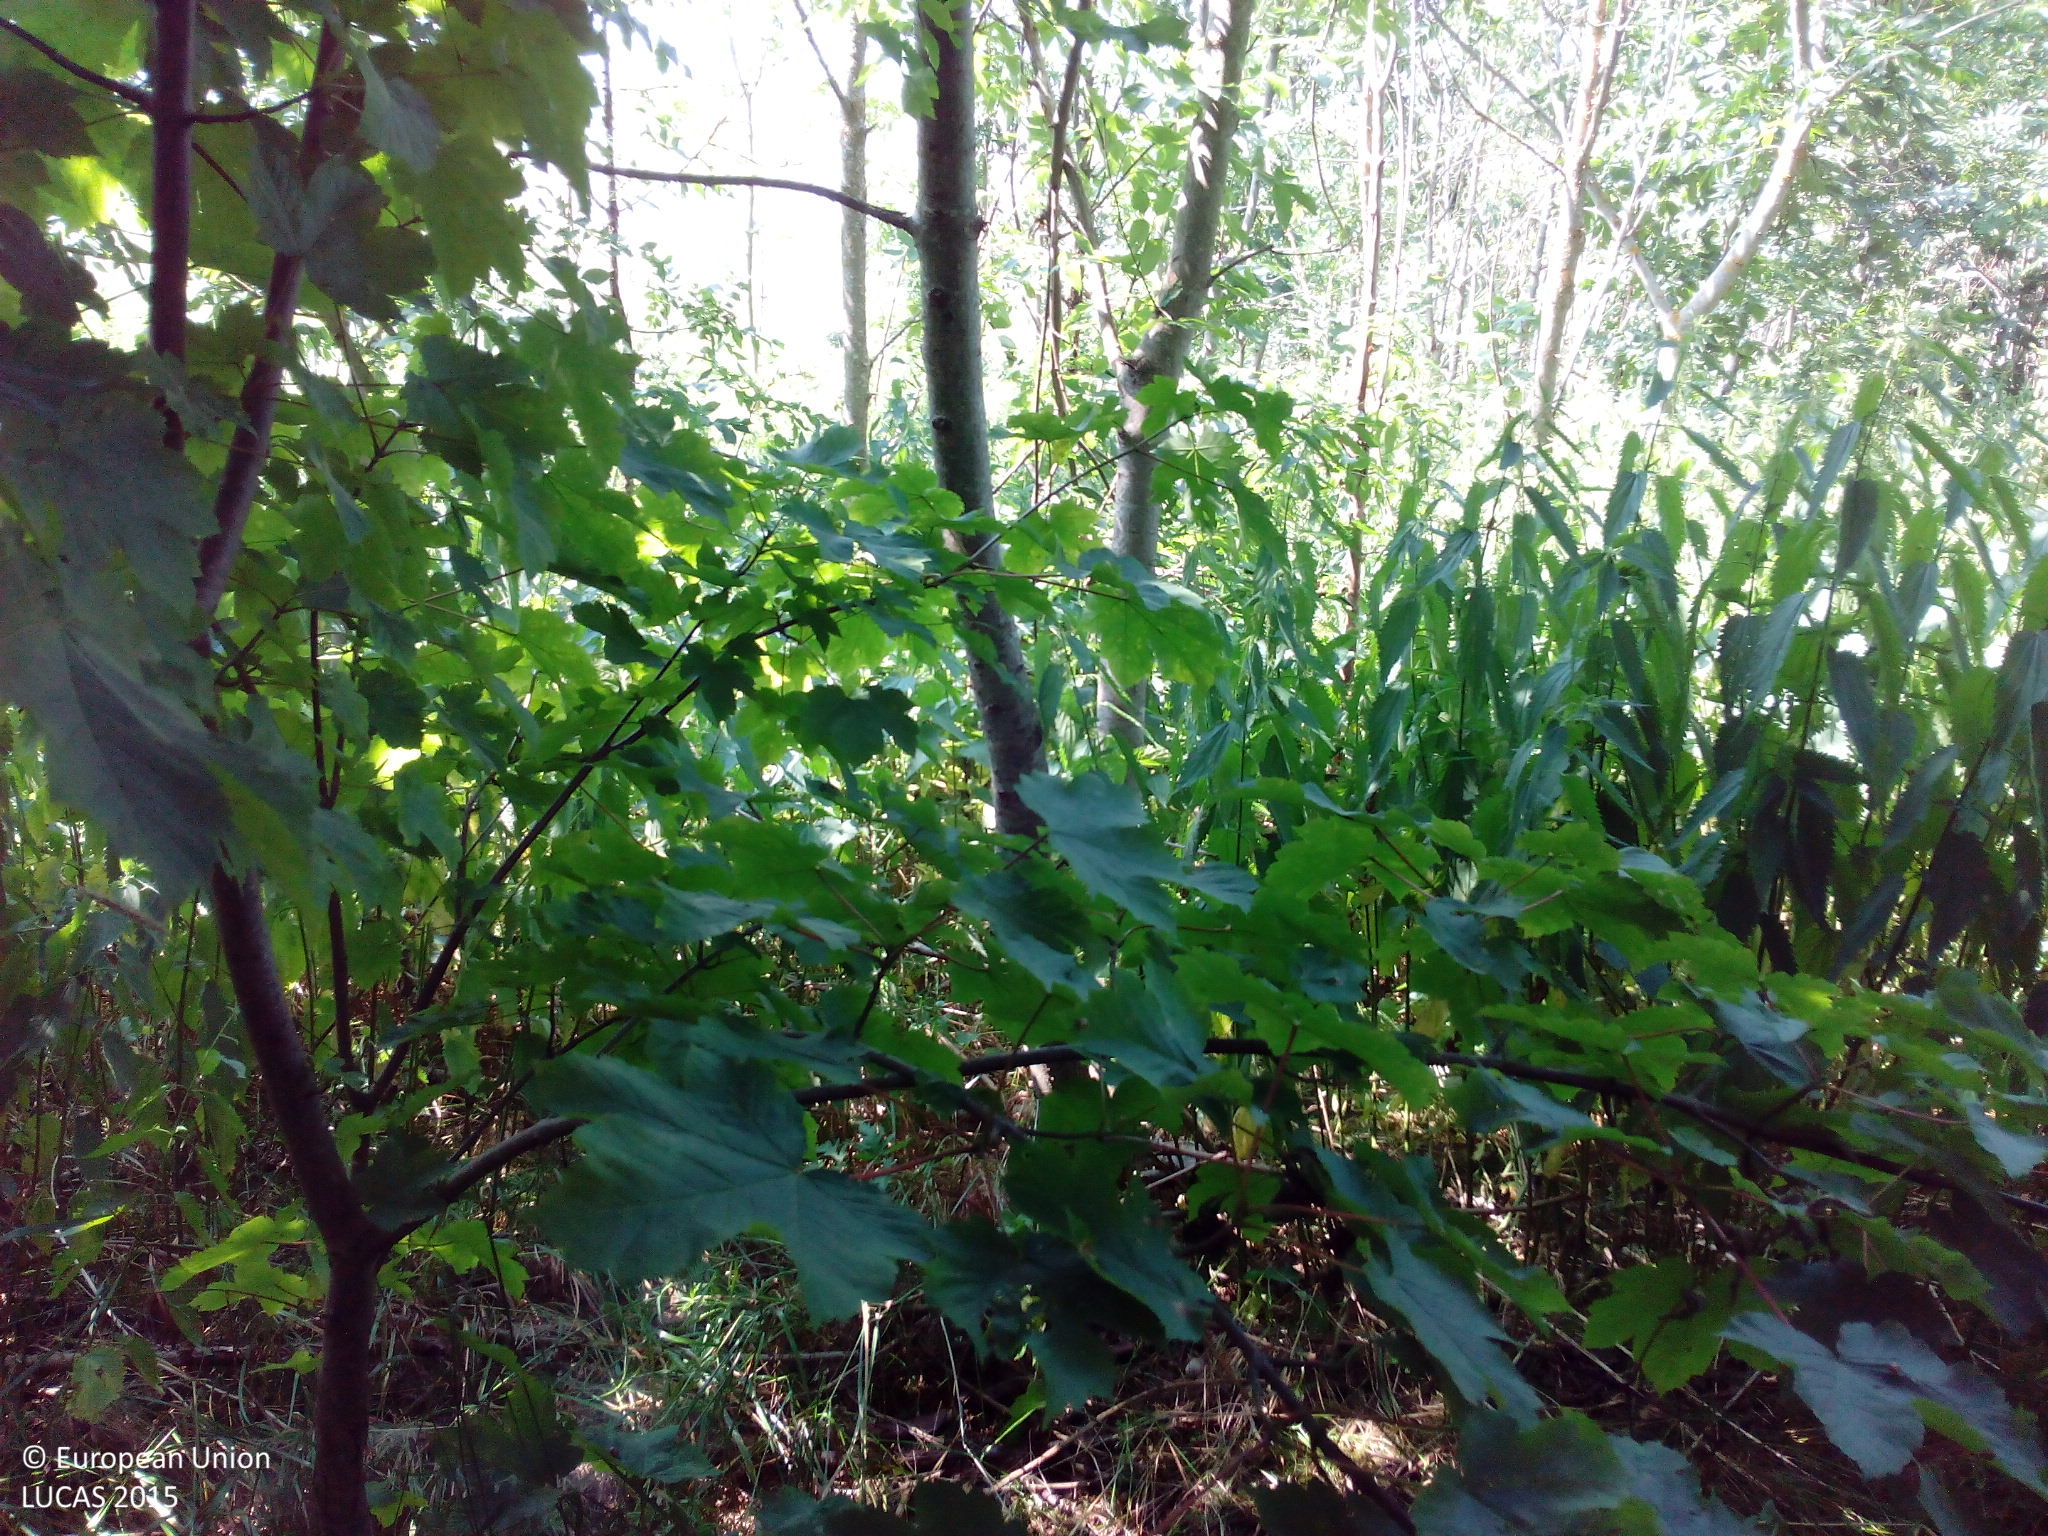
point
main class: Woodland
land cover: Broadleaved woodland
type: mesophytic deciduous forest
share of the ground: 50 - 75 %
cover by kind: broadleaved forest trees 75 %, herbaceous plants 25 %
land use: Forestry
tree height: < 5 m
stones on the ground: < 10 %
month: July
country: DE
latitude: 48.5290
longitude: 9.6887
